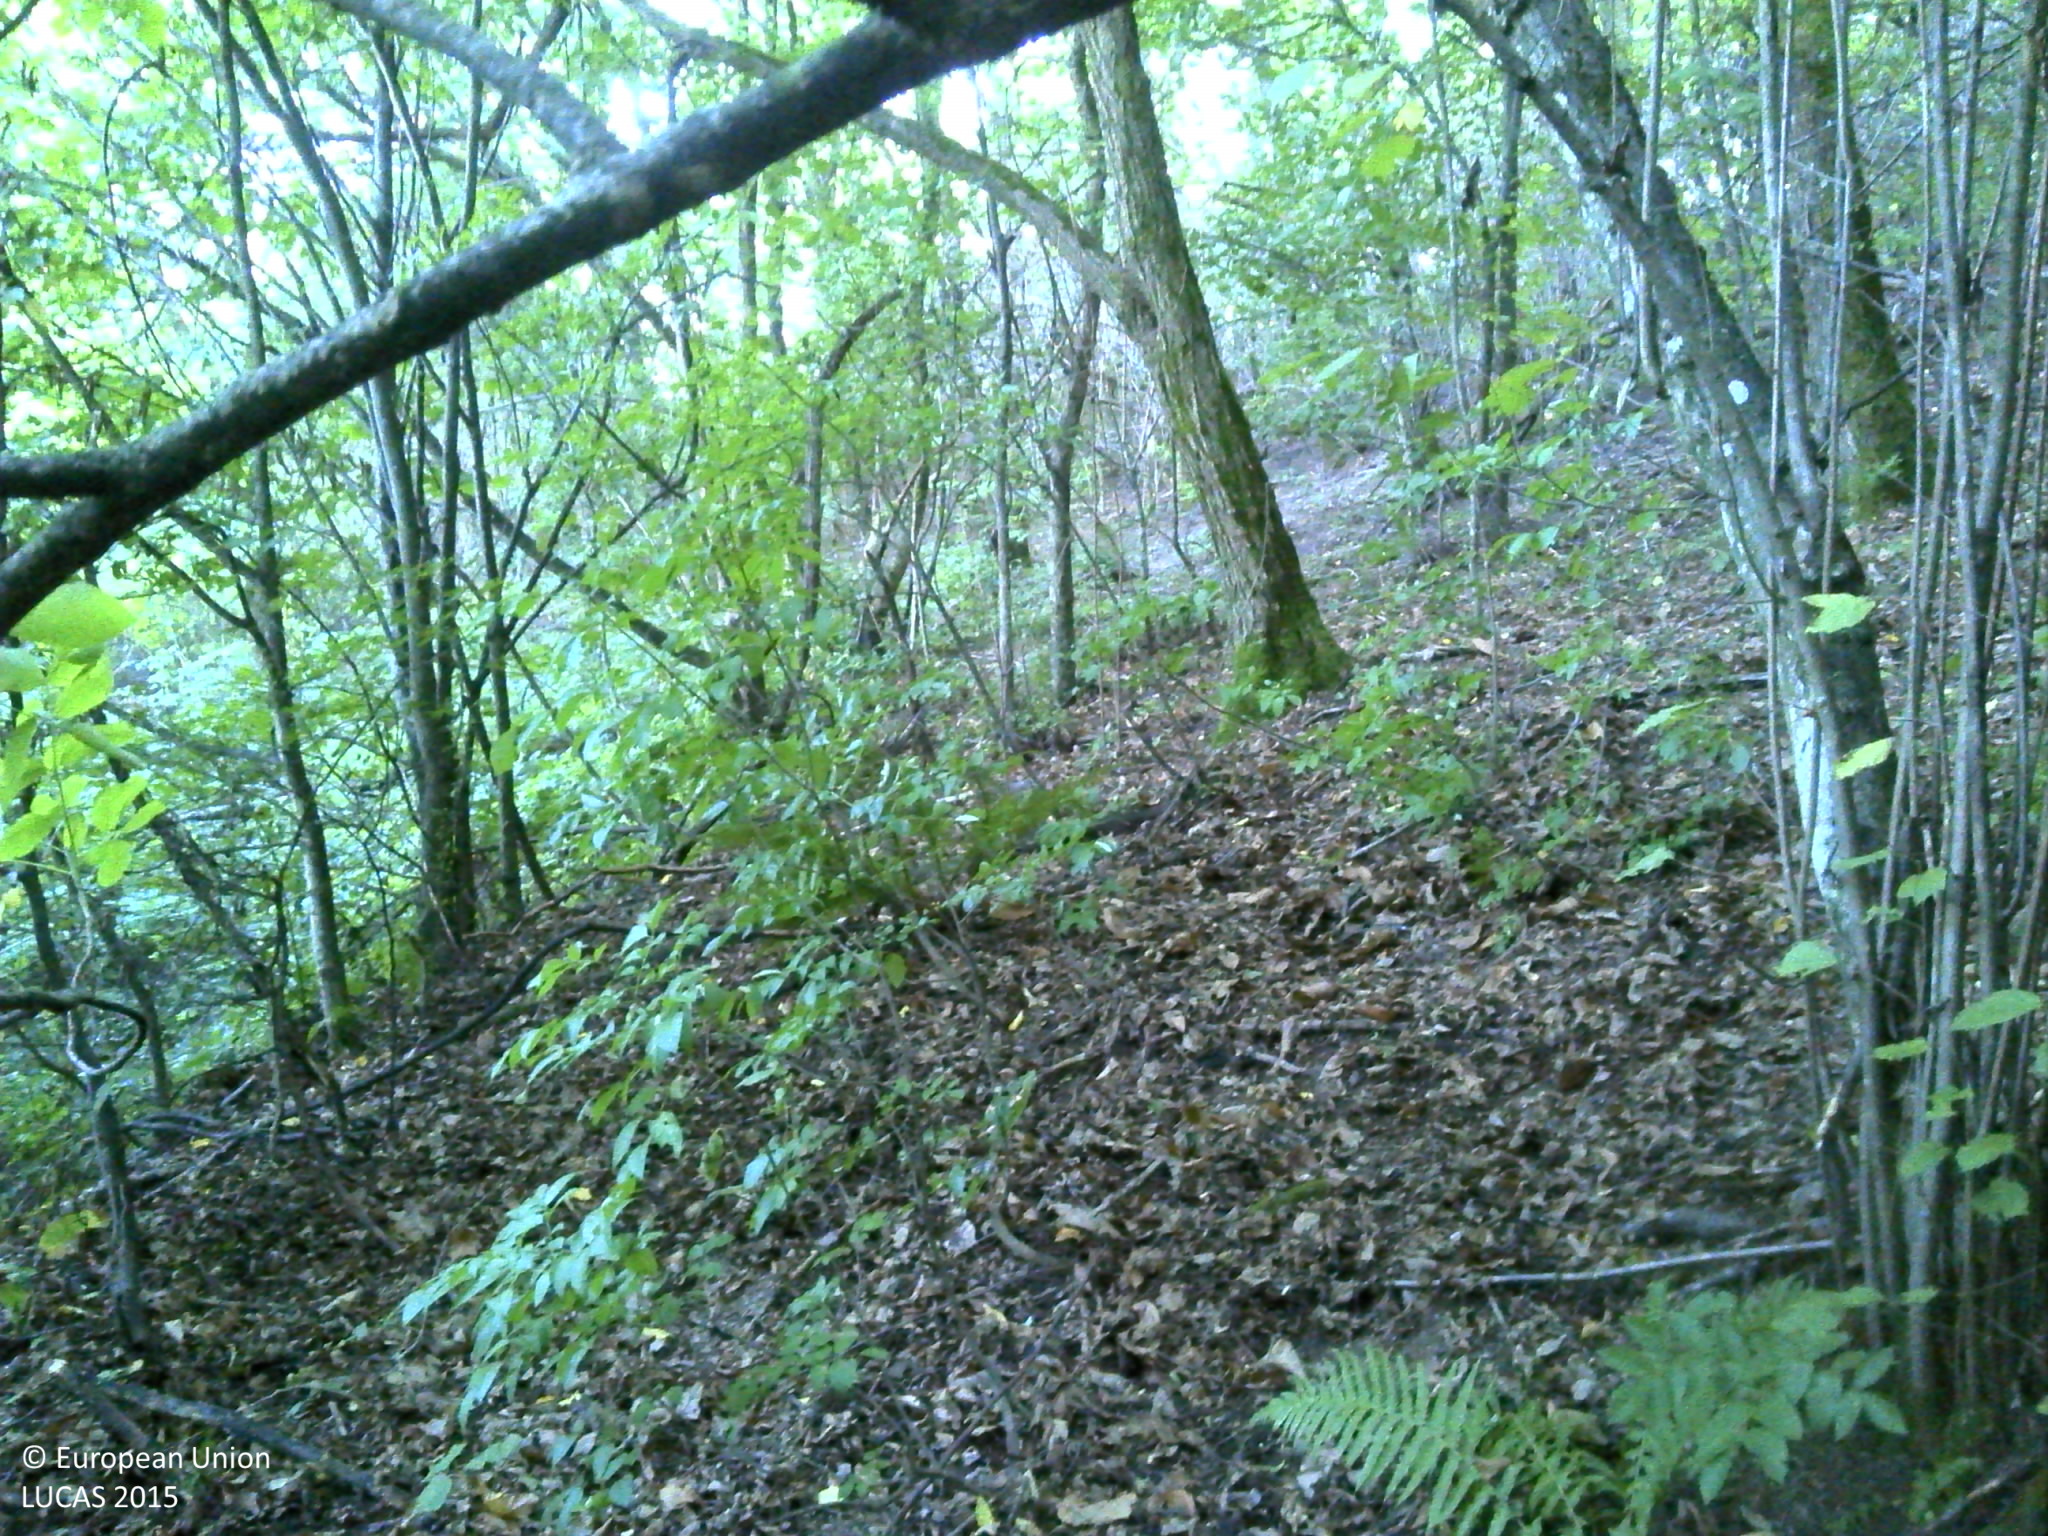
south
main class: Woodland
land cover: Broadleaved woodland
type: acidophilous oak and oak-birch forest
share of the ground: > 75 %
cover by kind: broadleaved forest trees 100 %
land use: Forestry
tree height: > 5 m
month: August
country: HR
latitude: 45.2586
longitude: 16.3560
